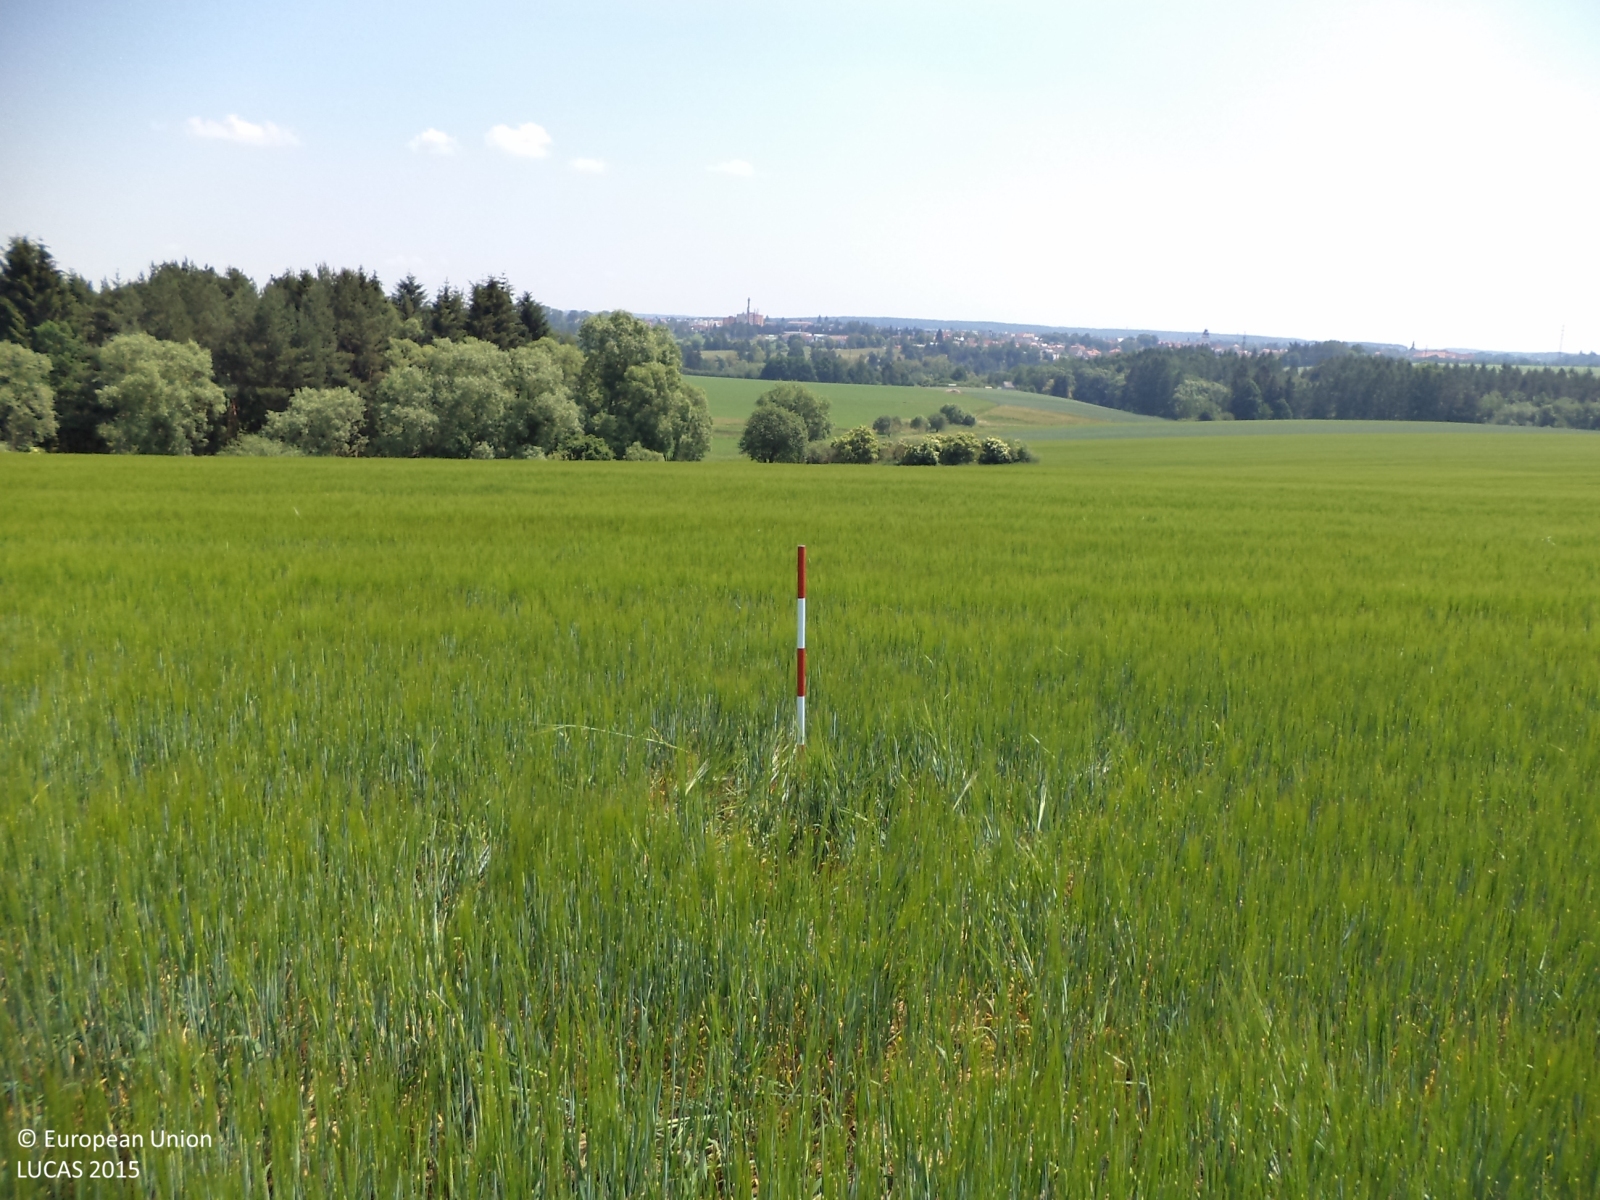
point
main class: Cropland
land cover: Barley
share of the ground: > 75 %
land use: Agriculture (excluding fallow land and kitchen gardens)
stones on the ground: < 10 %
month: June
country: CZ
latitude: 49.3052
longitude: 14.4436
